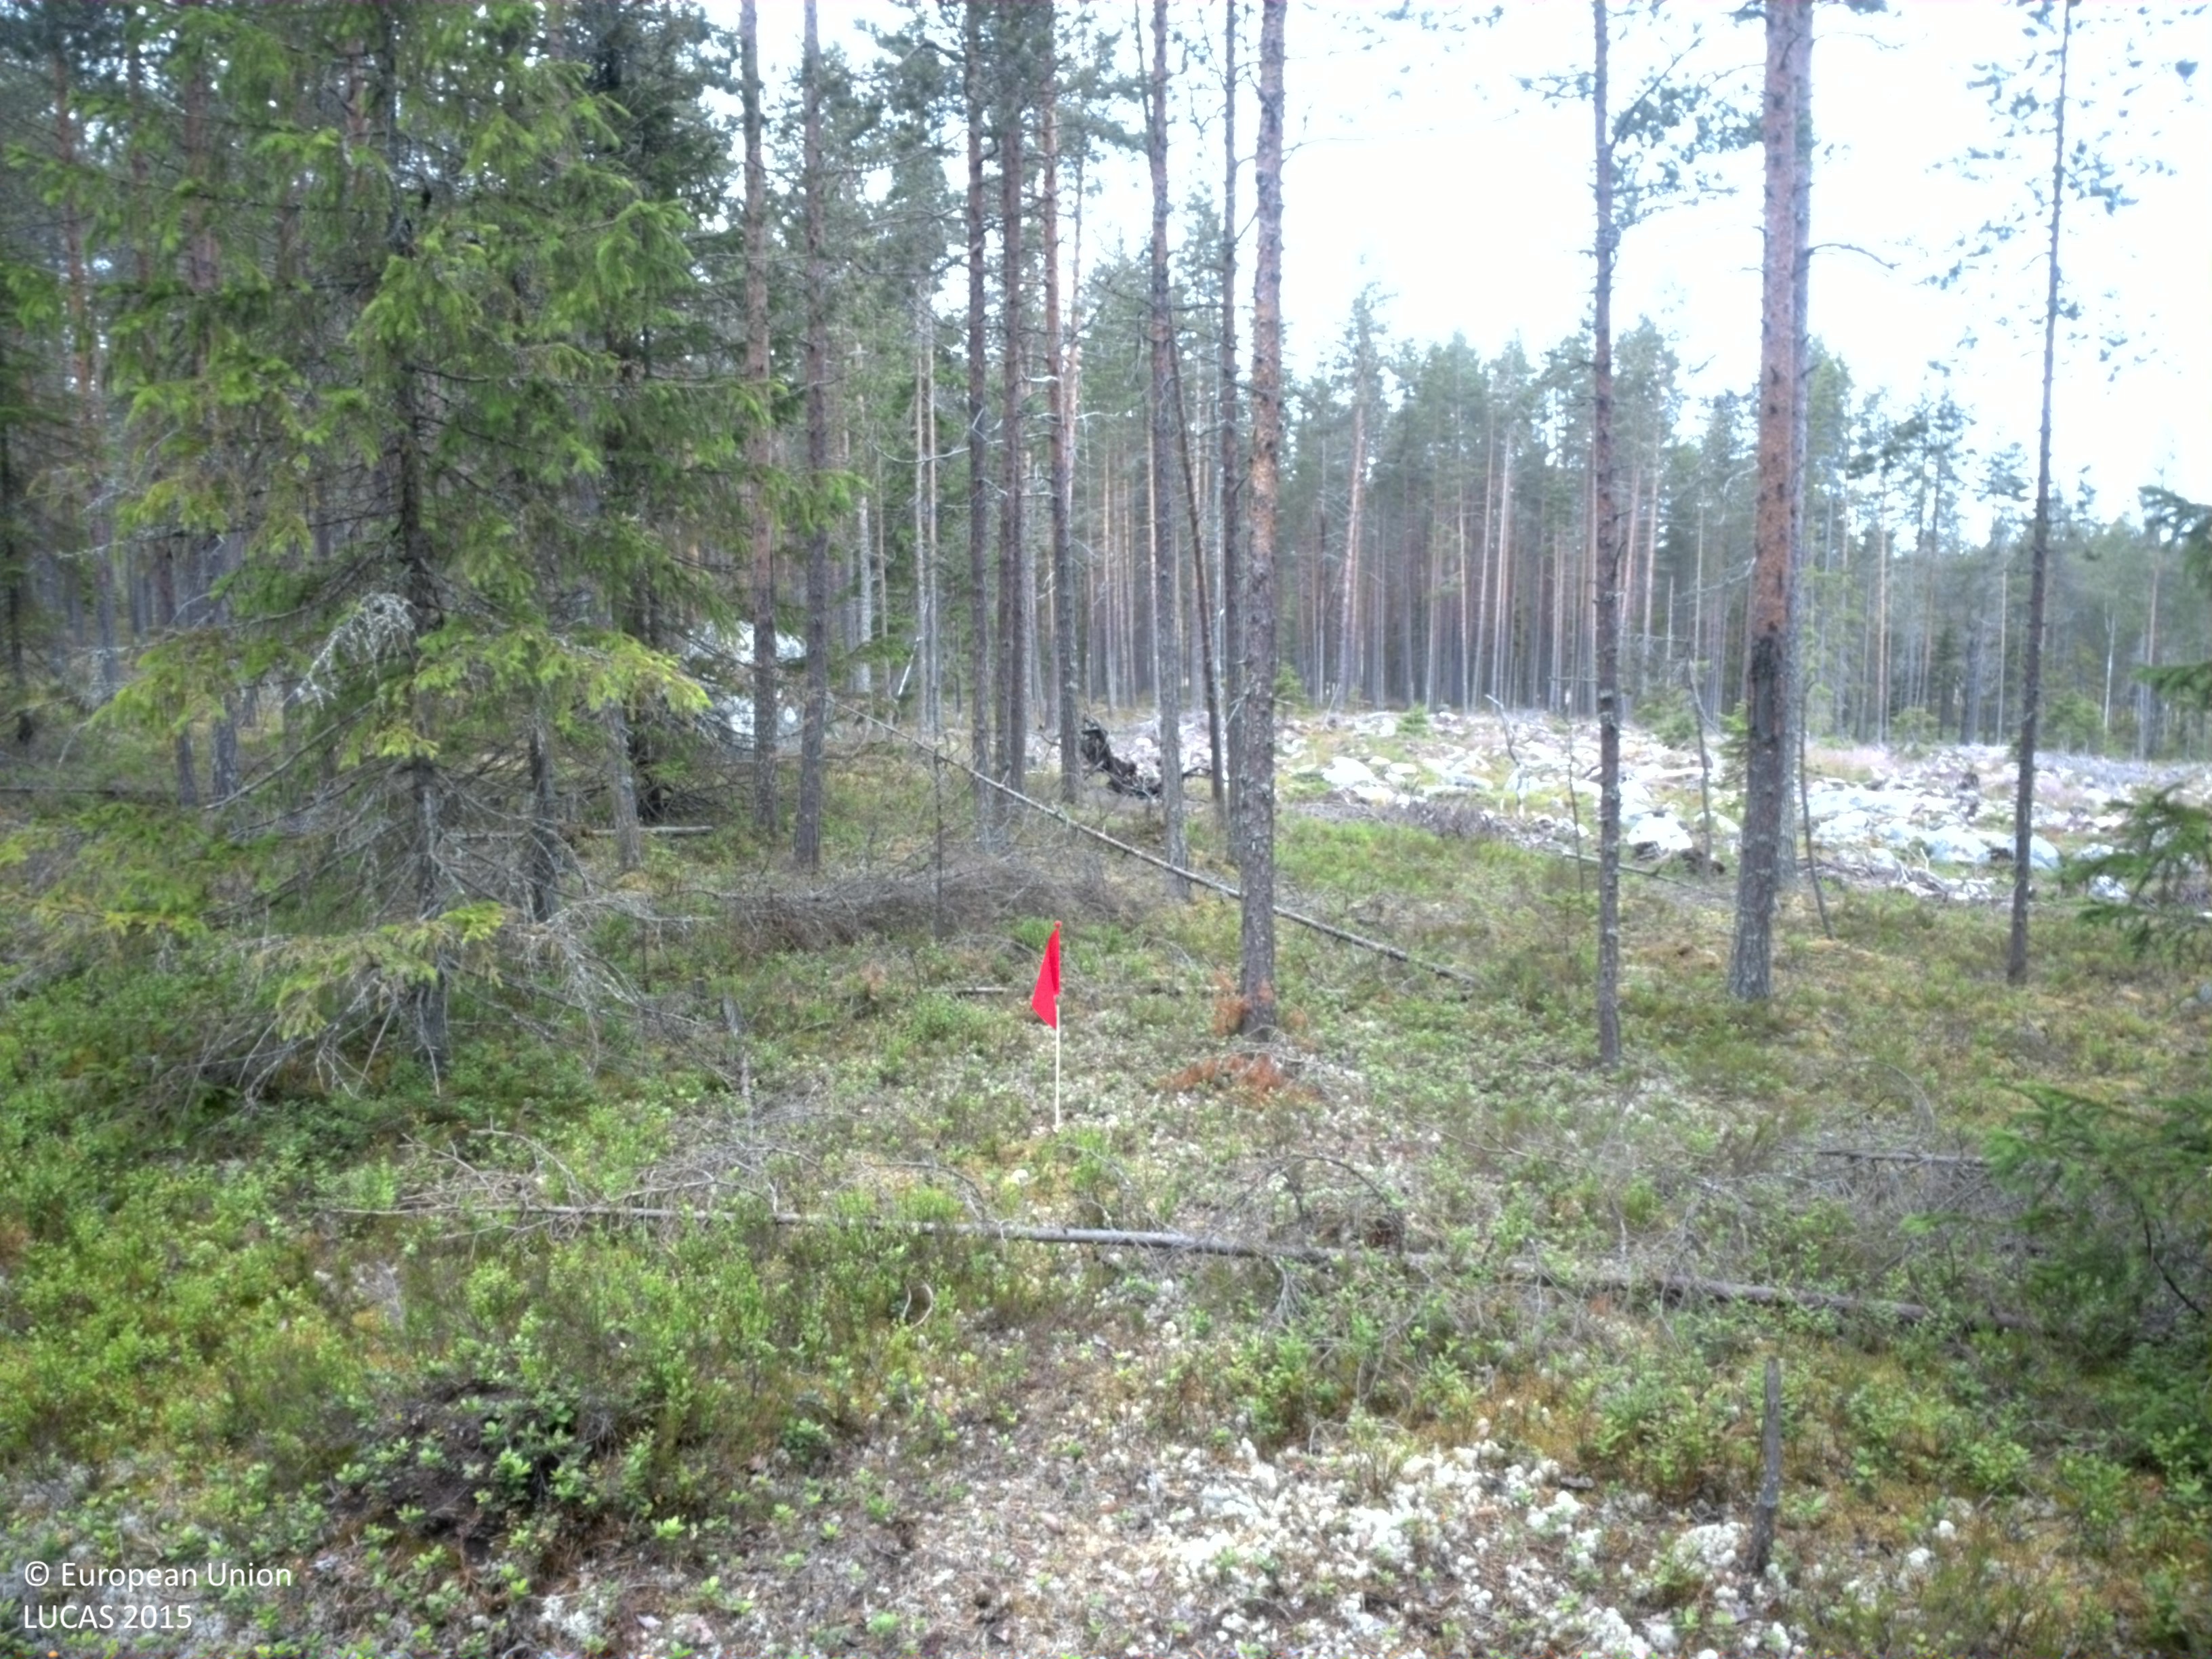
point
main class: Woodland
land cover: Pine dominated coniferous woodland
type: boreal forest
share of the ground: 50 - 75 %
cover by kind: coniferous forest trees 65 %, shrubs 30 %, lichens and mosses 5 %
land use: Forestry
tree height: > 5 m
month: July
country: SE
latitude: 64.5416
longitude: 21.3047
